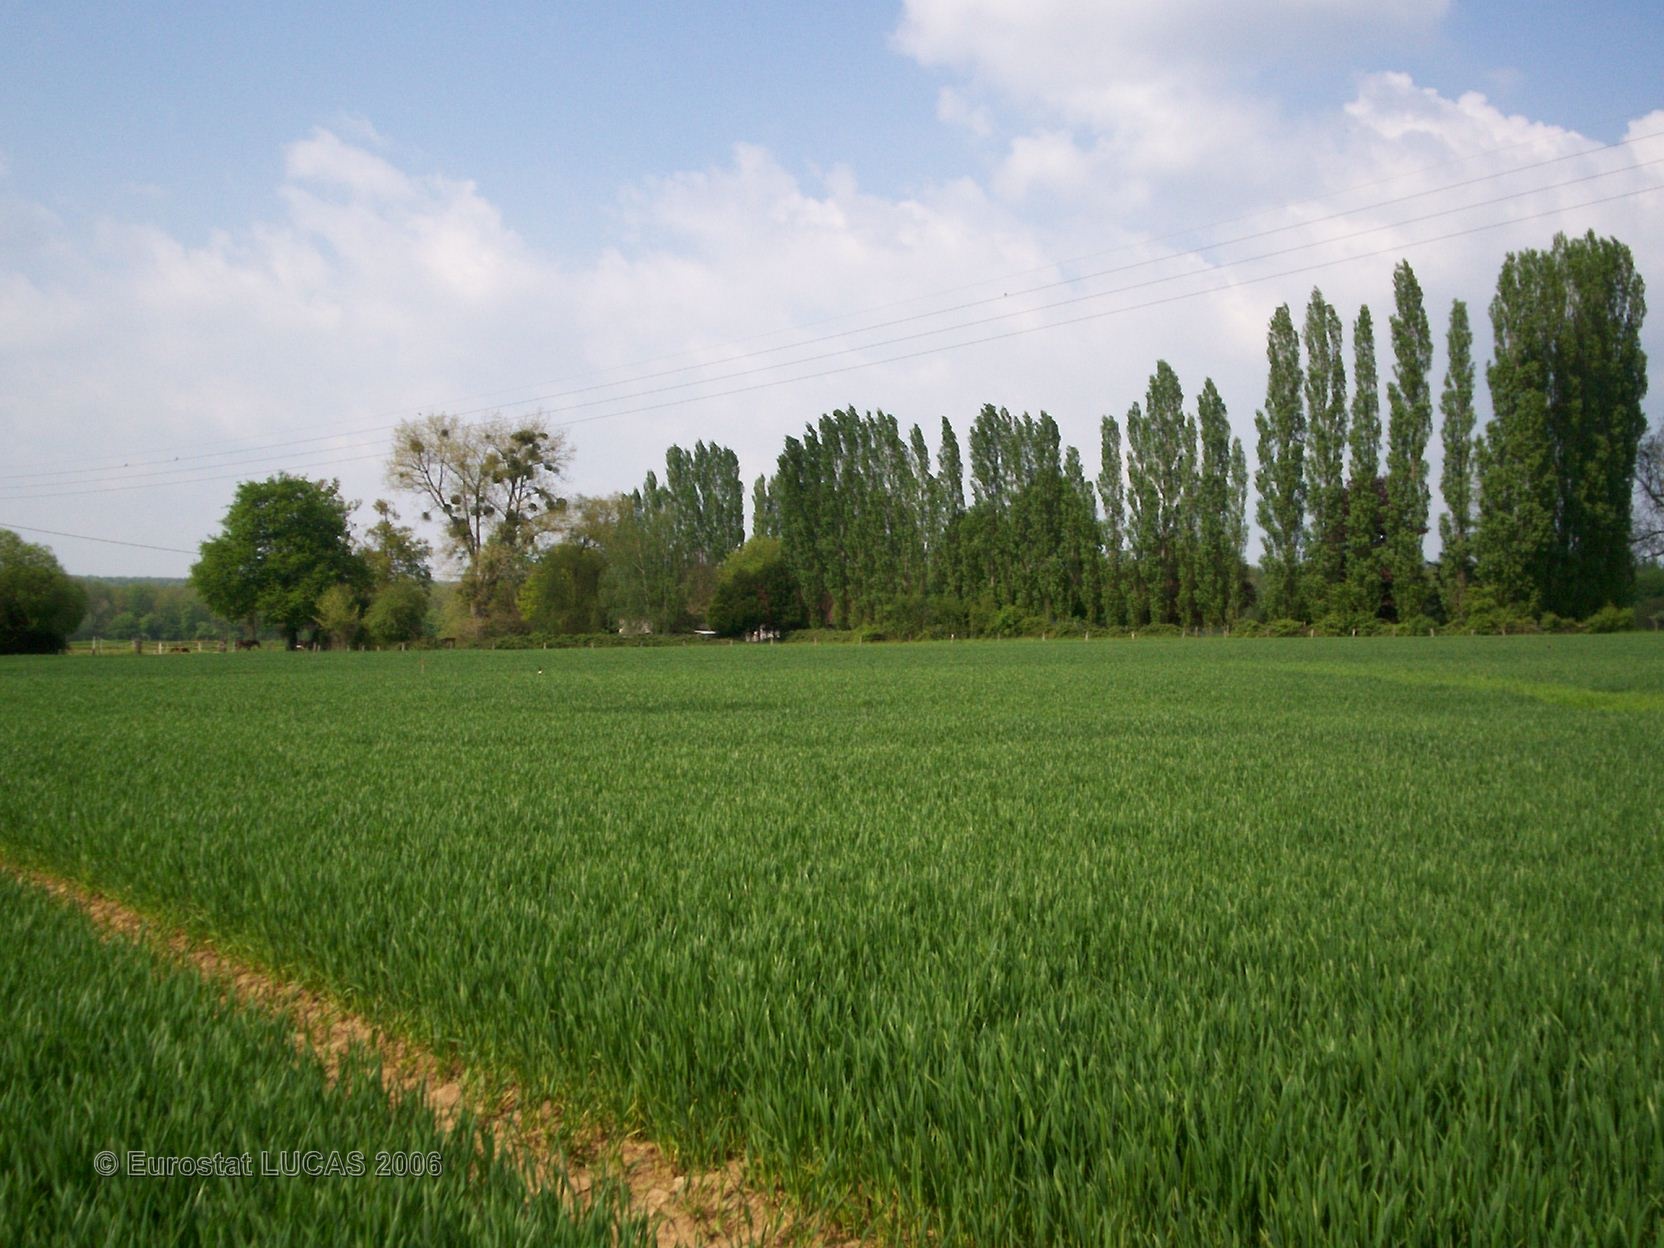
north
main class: Cropland
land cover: Common wheat
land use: Agriculture (excluding fallow land and kitchen gardens)
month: May
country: FR
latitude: 48.5191
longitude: 0.2930
